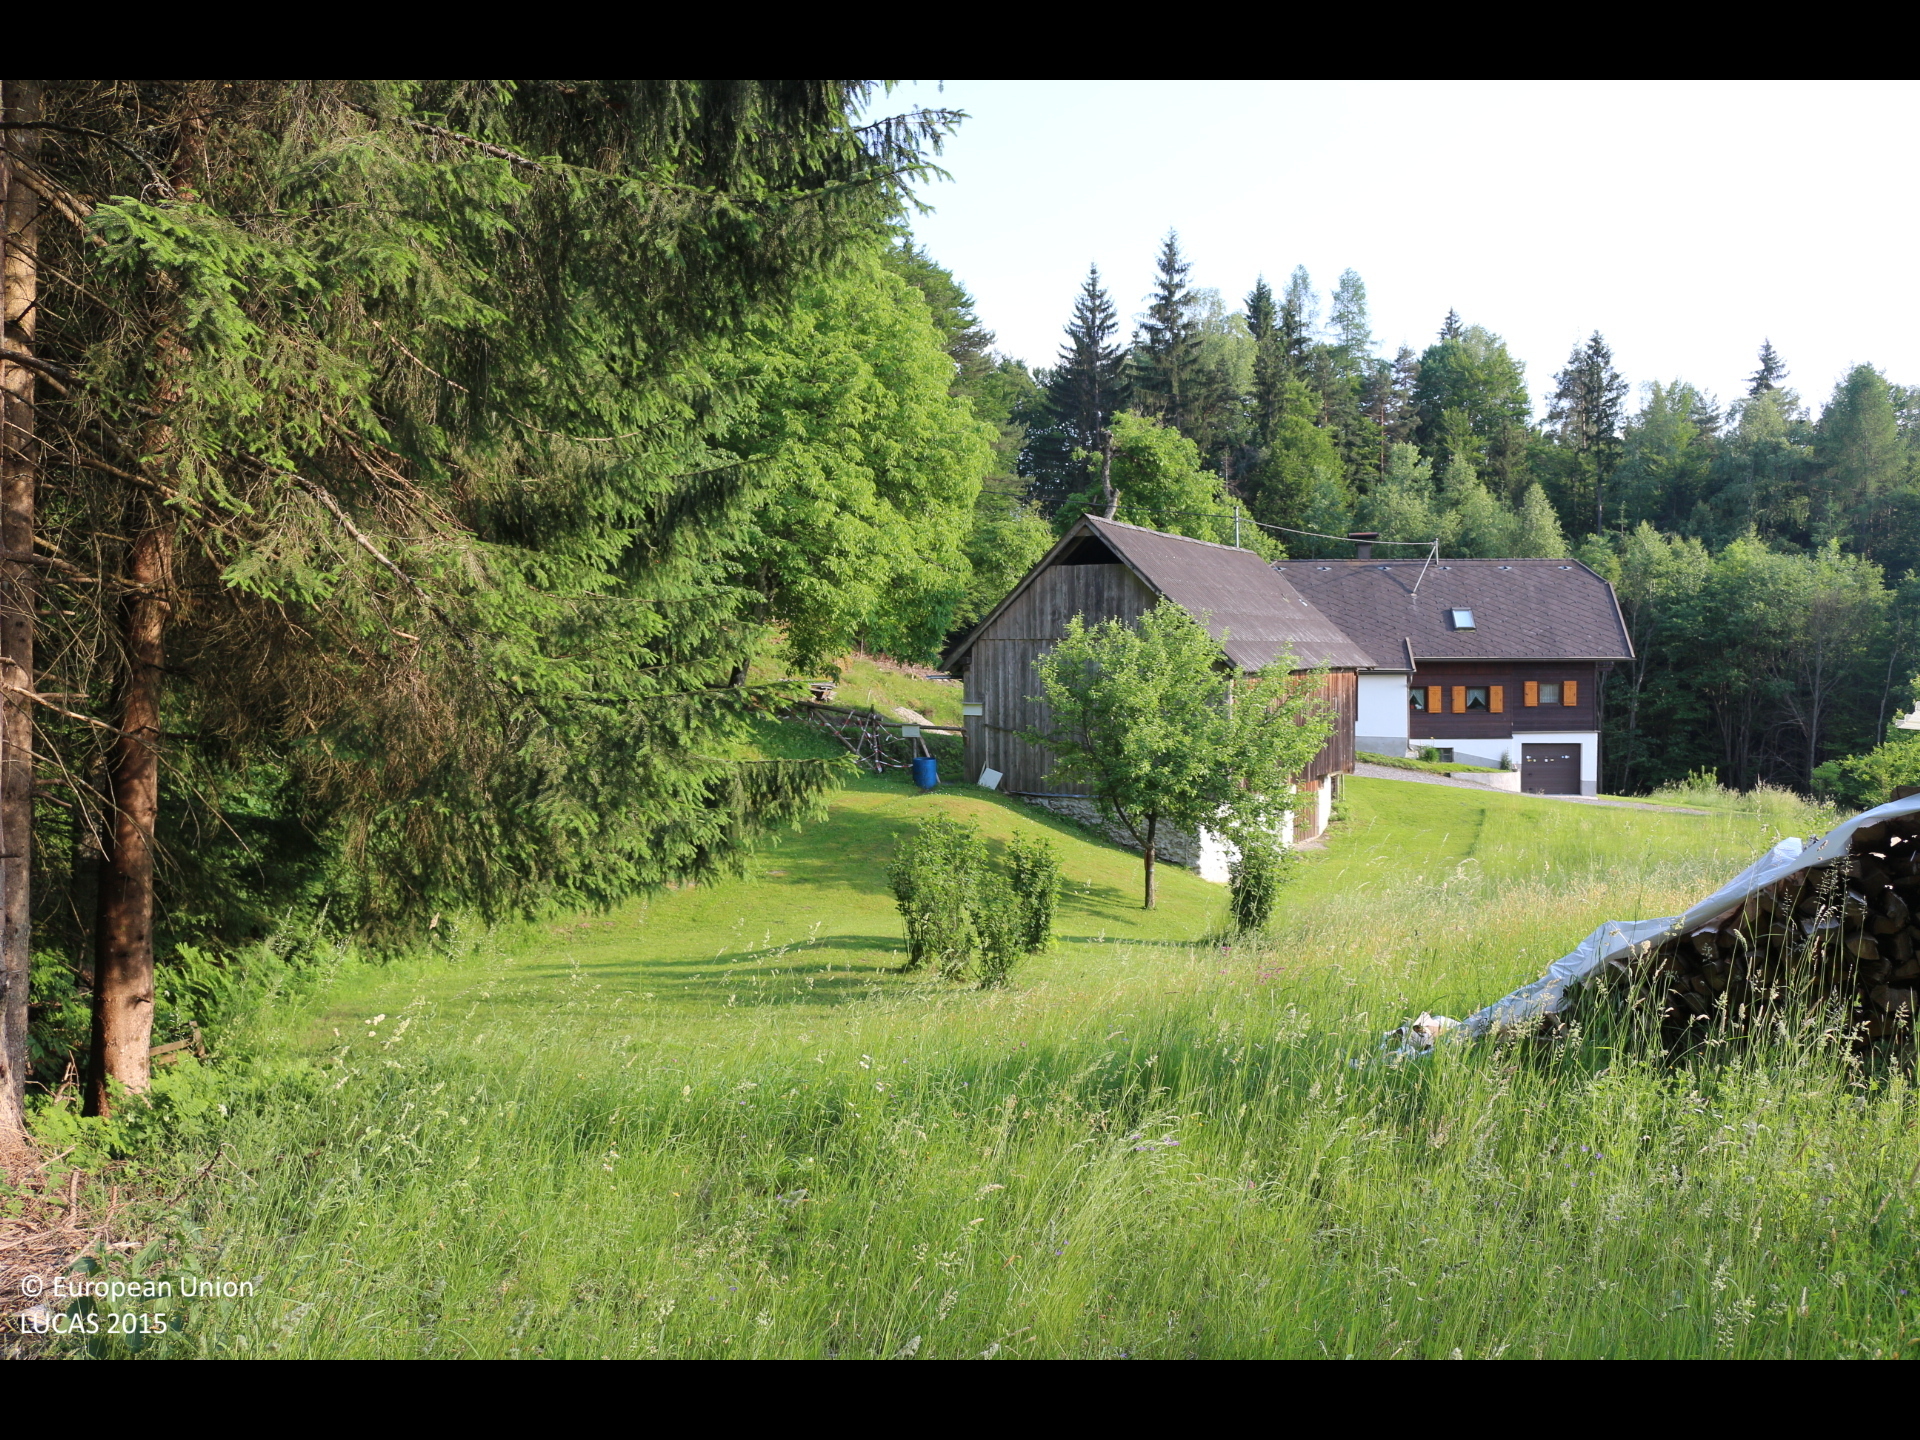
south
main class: Grassland
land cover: Grassland without tree/shrub cover
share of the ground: > 75 %
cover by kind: herbaceous plants 100 %
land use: Agriculture (excluding fallow land and kitchen gardens)
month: June
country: AT
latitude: 46.6557
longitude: 13.9829
